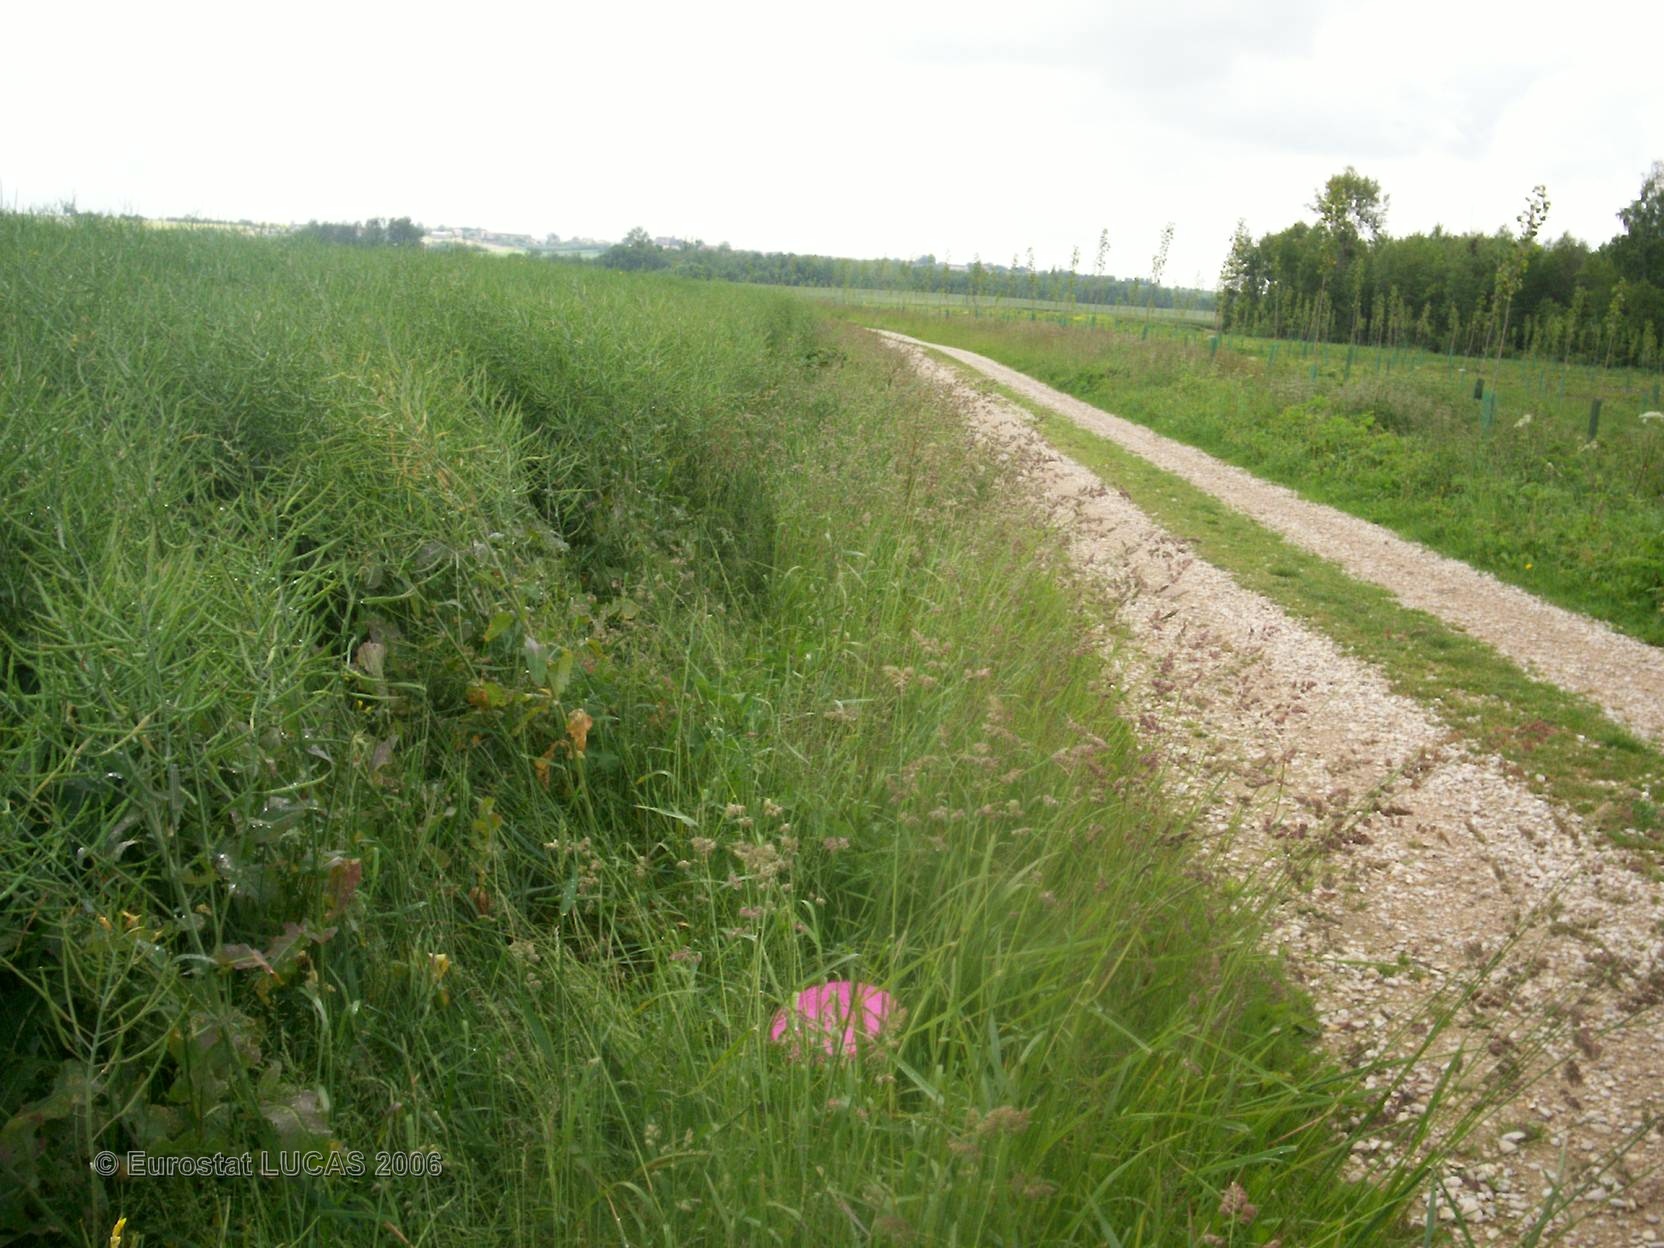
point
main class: Cropland
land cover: Rape and turnip rape
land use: Agriculture (excluding fallow land and kitchen gardens)
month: June
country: FR
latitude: 48.5736
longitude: 4.5080
